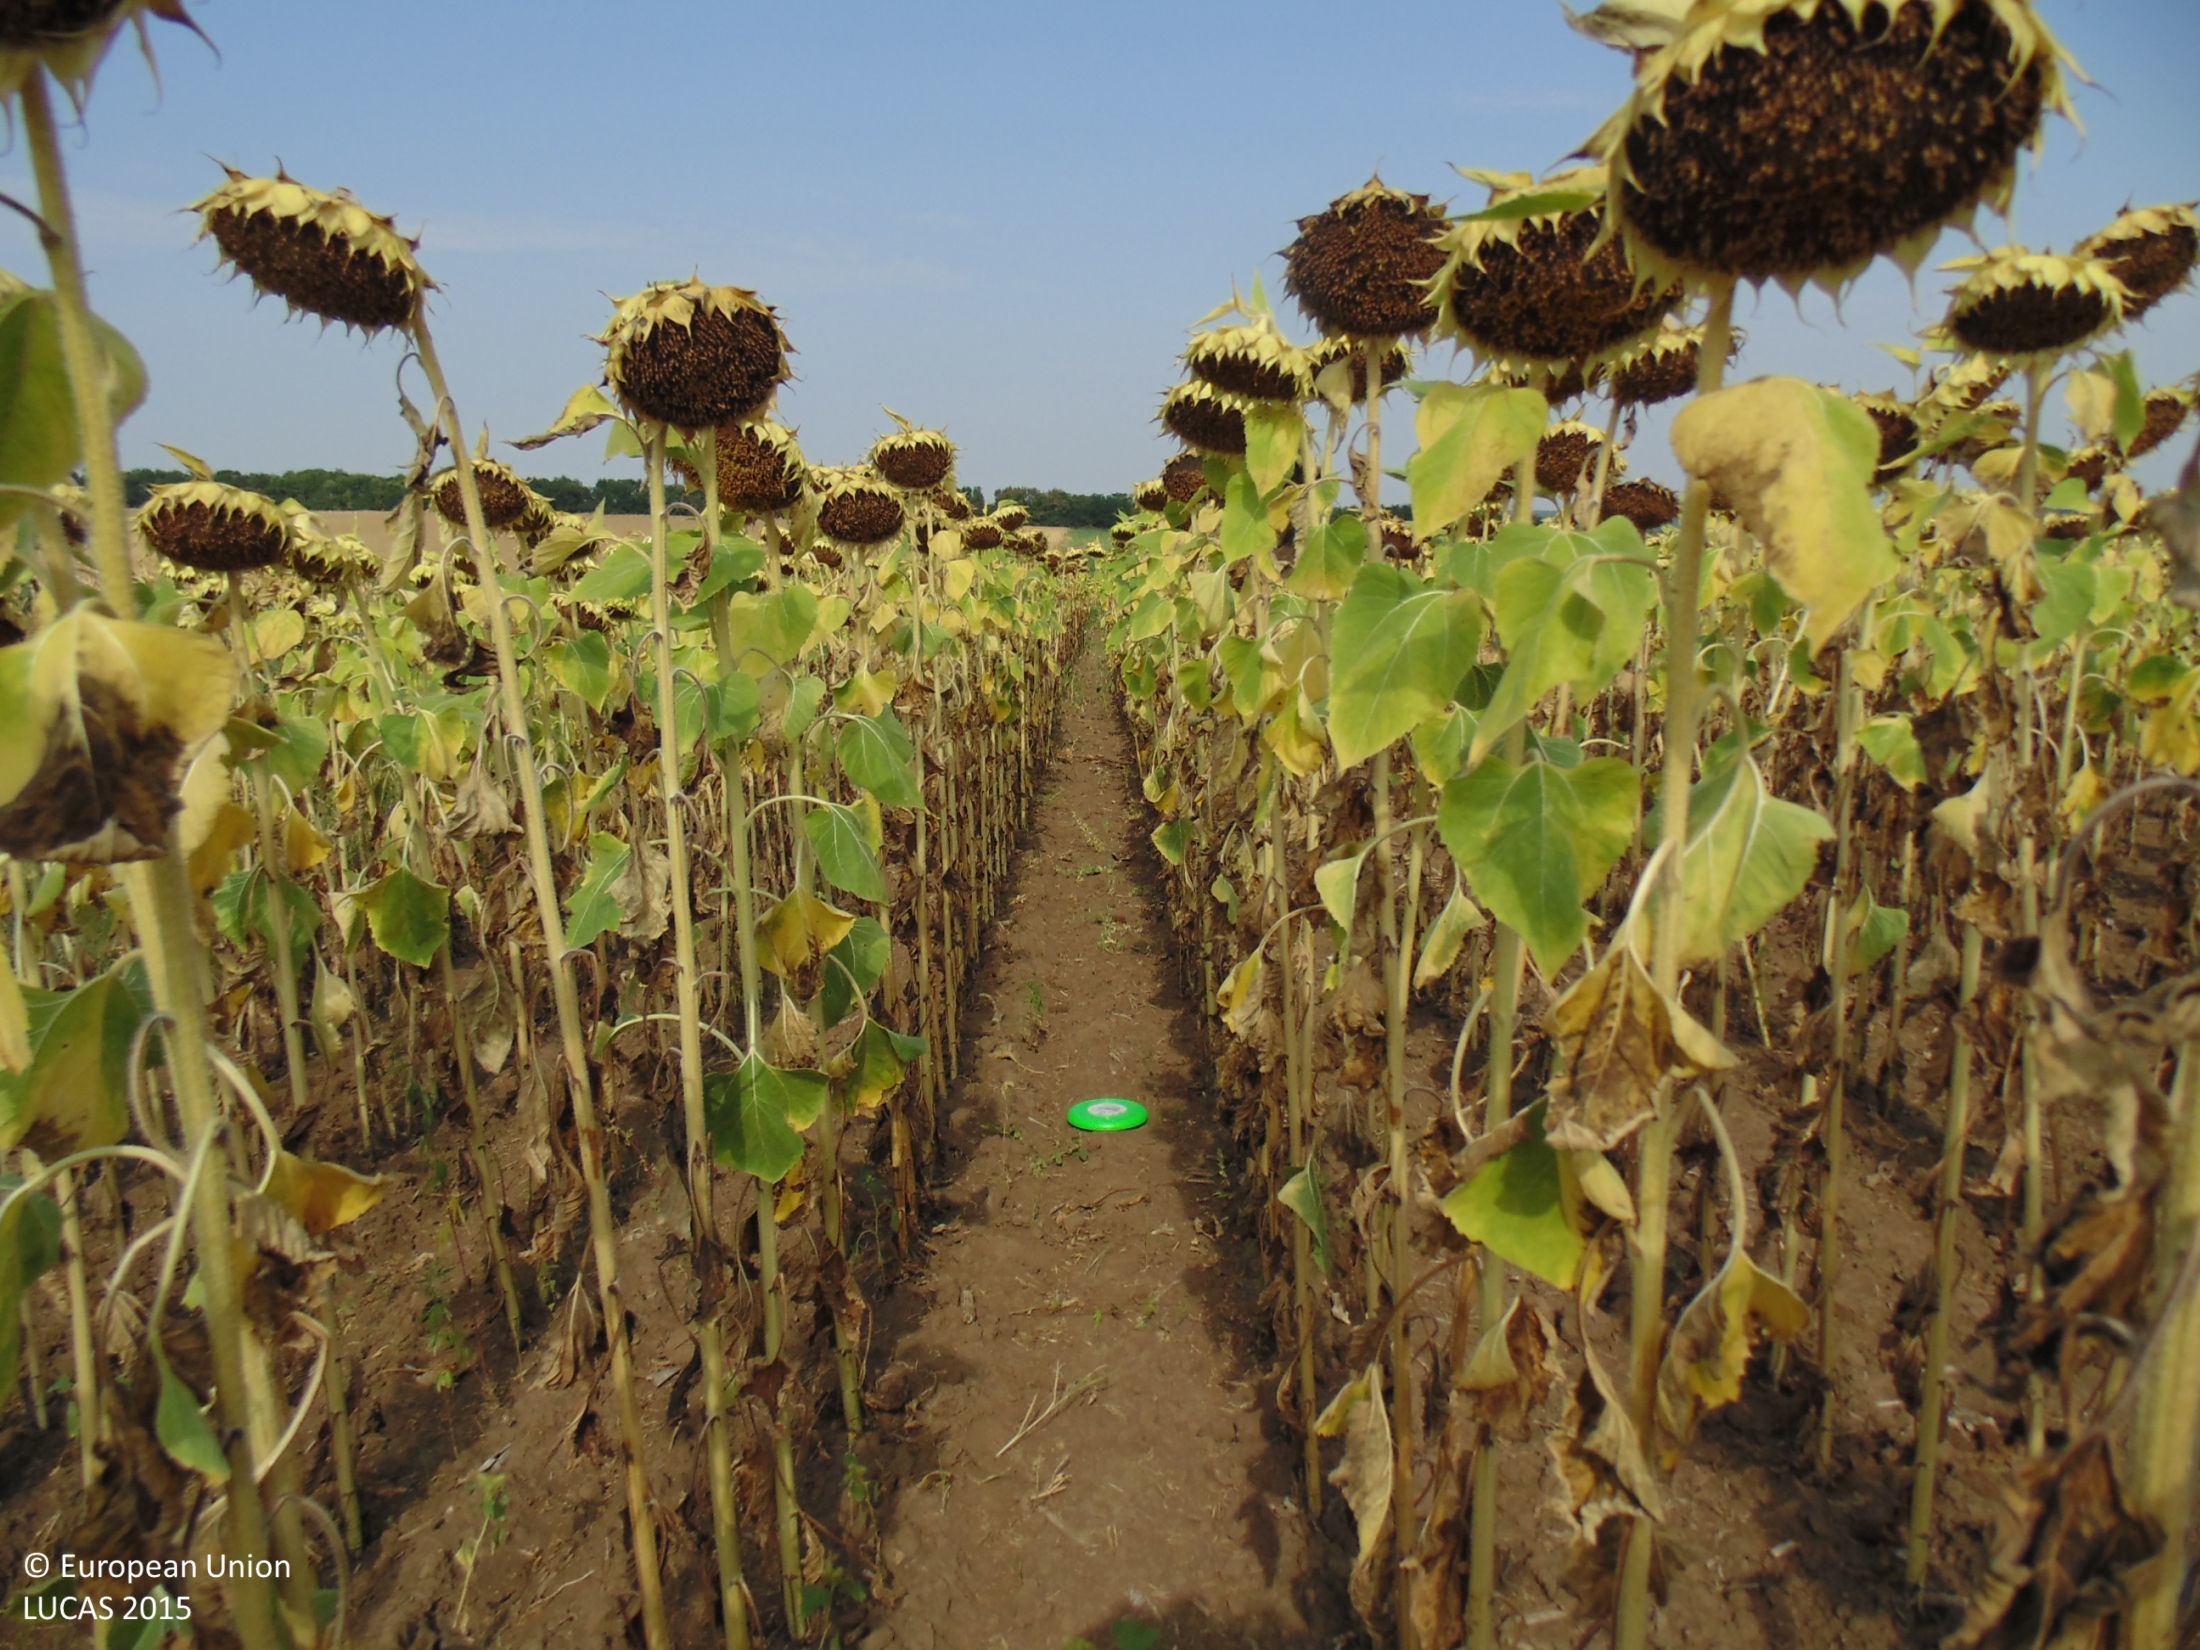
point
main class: Cropland
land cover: Sunflower
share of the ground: > 75 %
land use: Agriculture (excluding fallow land and kitchen gardens)
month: August
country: BG
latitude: 43.7253
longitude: 27.6540
